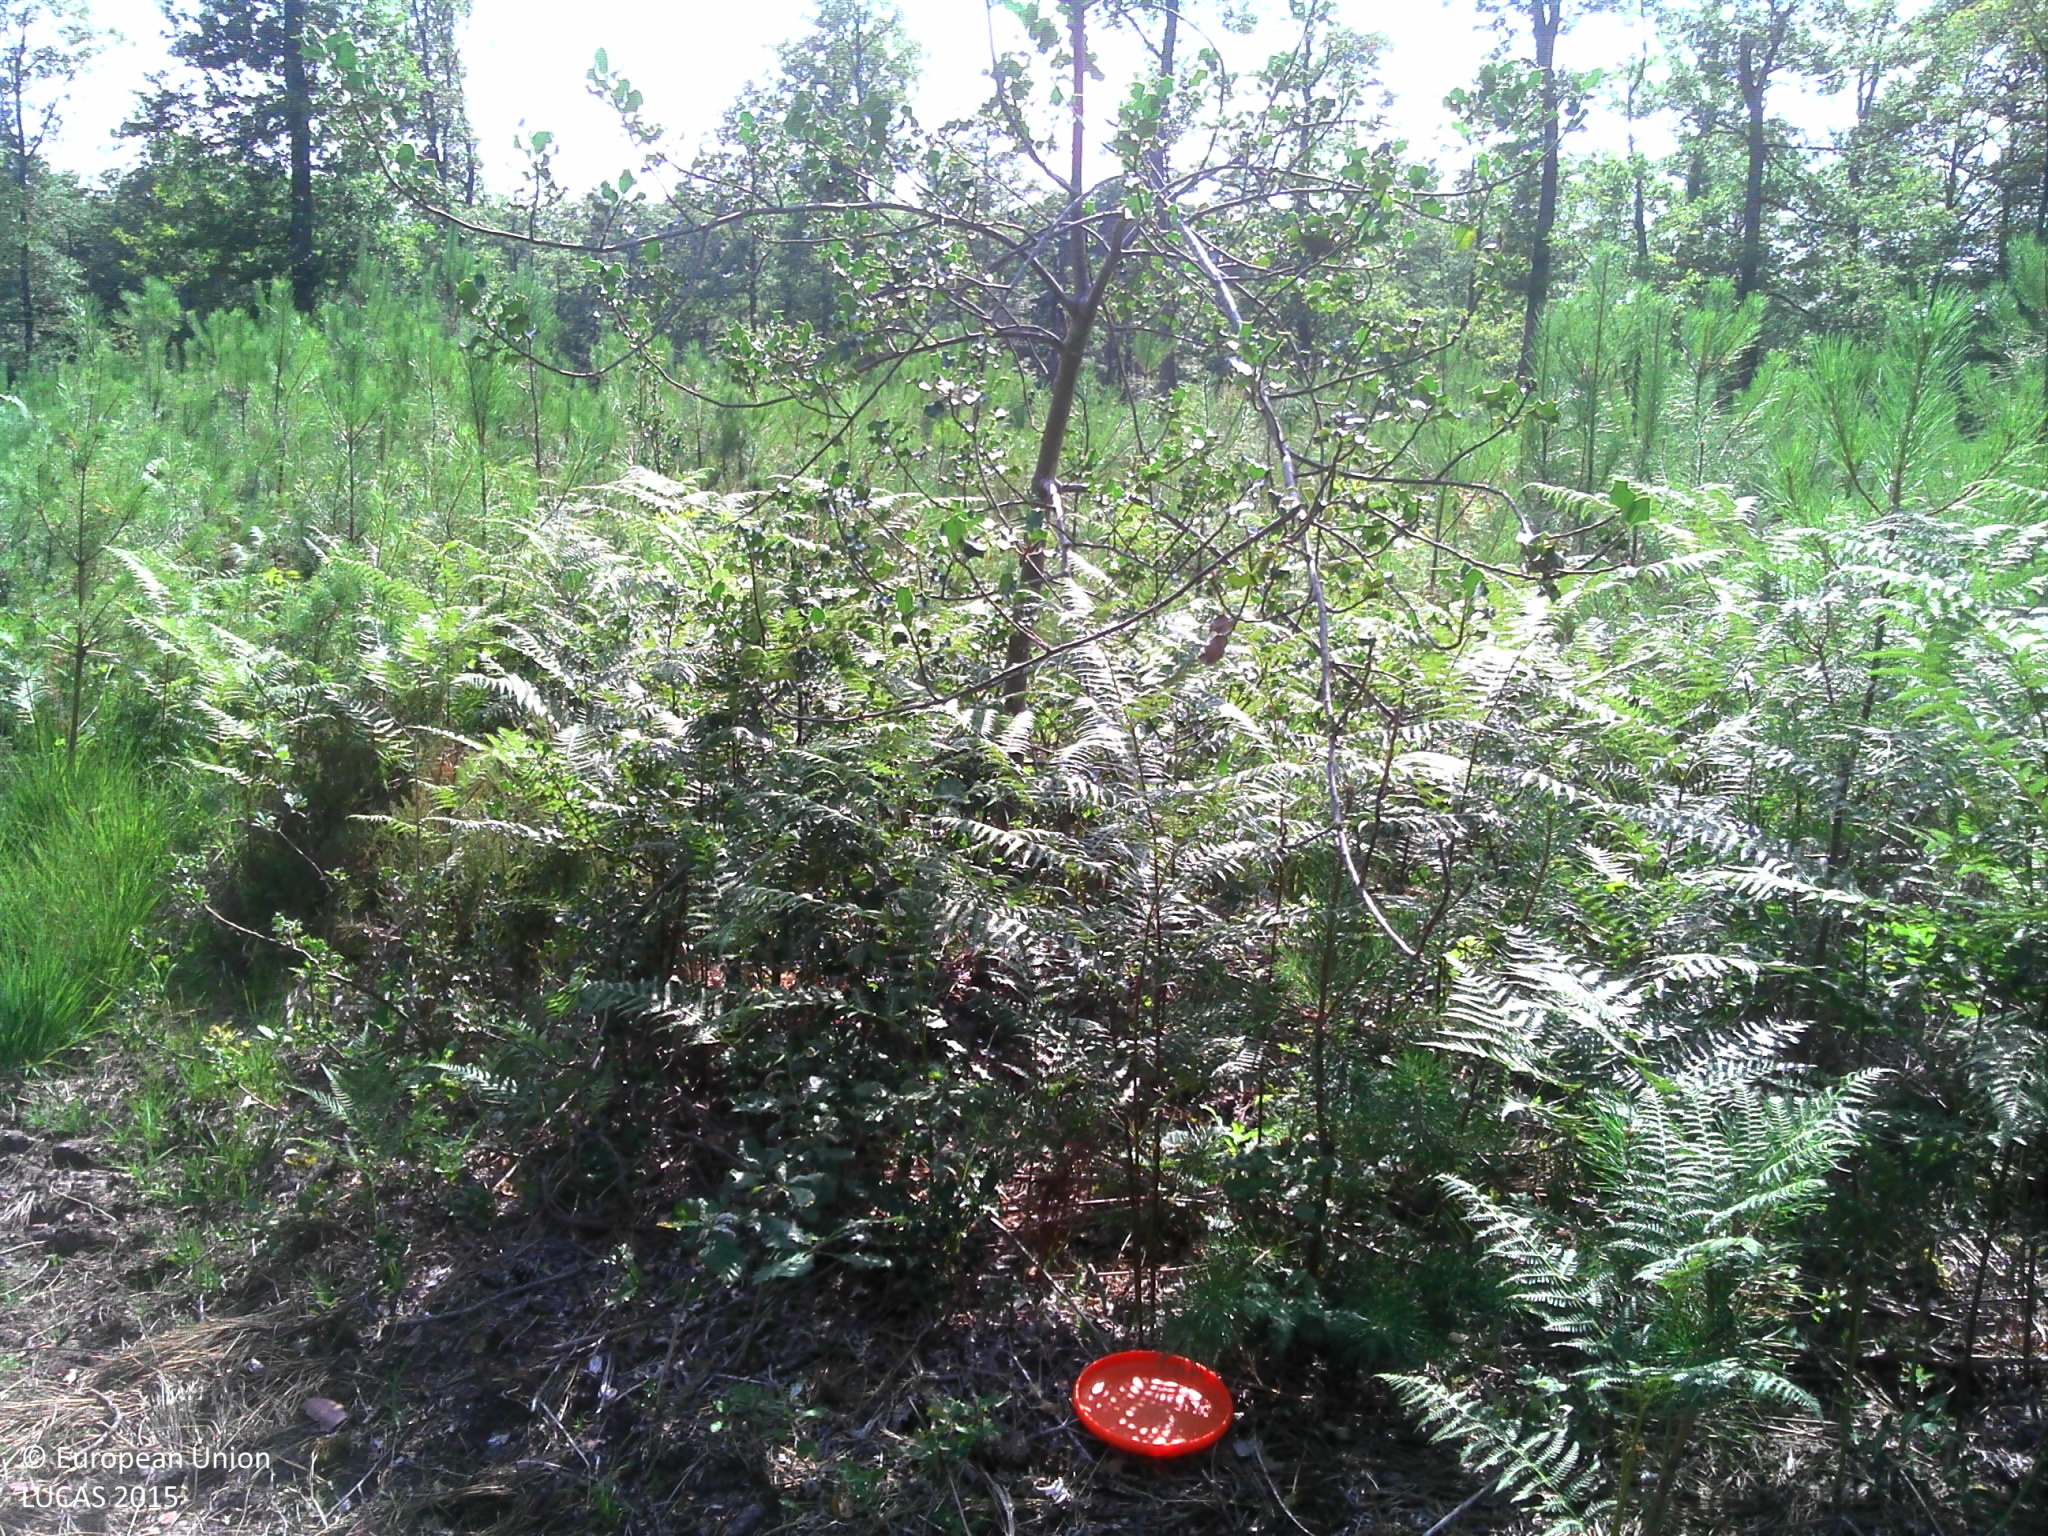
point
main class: Woodland
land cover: Pine dominated mixed woodland
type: exotic forest
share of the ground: > 75 %
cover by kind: coniferous forest trees 40 %, broadleaved forest trees 25 %, shrubs 20 %, herbaceous plants 10 %, lichens and mosses 5 %
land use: Forestry
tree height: < 5 m
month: July
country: FR
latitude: 47.2396
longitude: 0.3747
